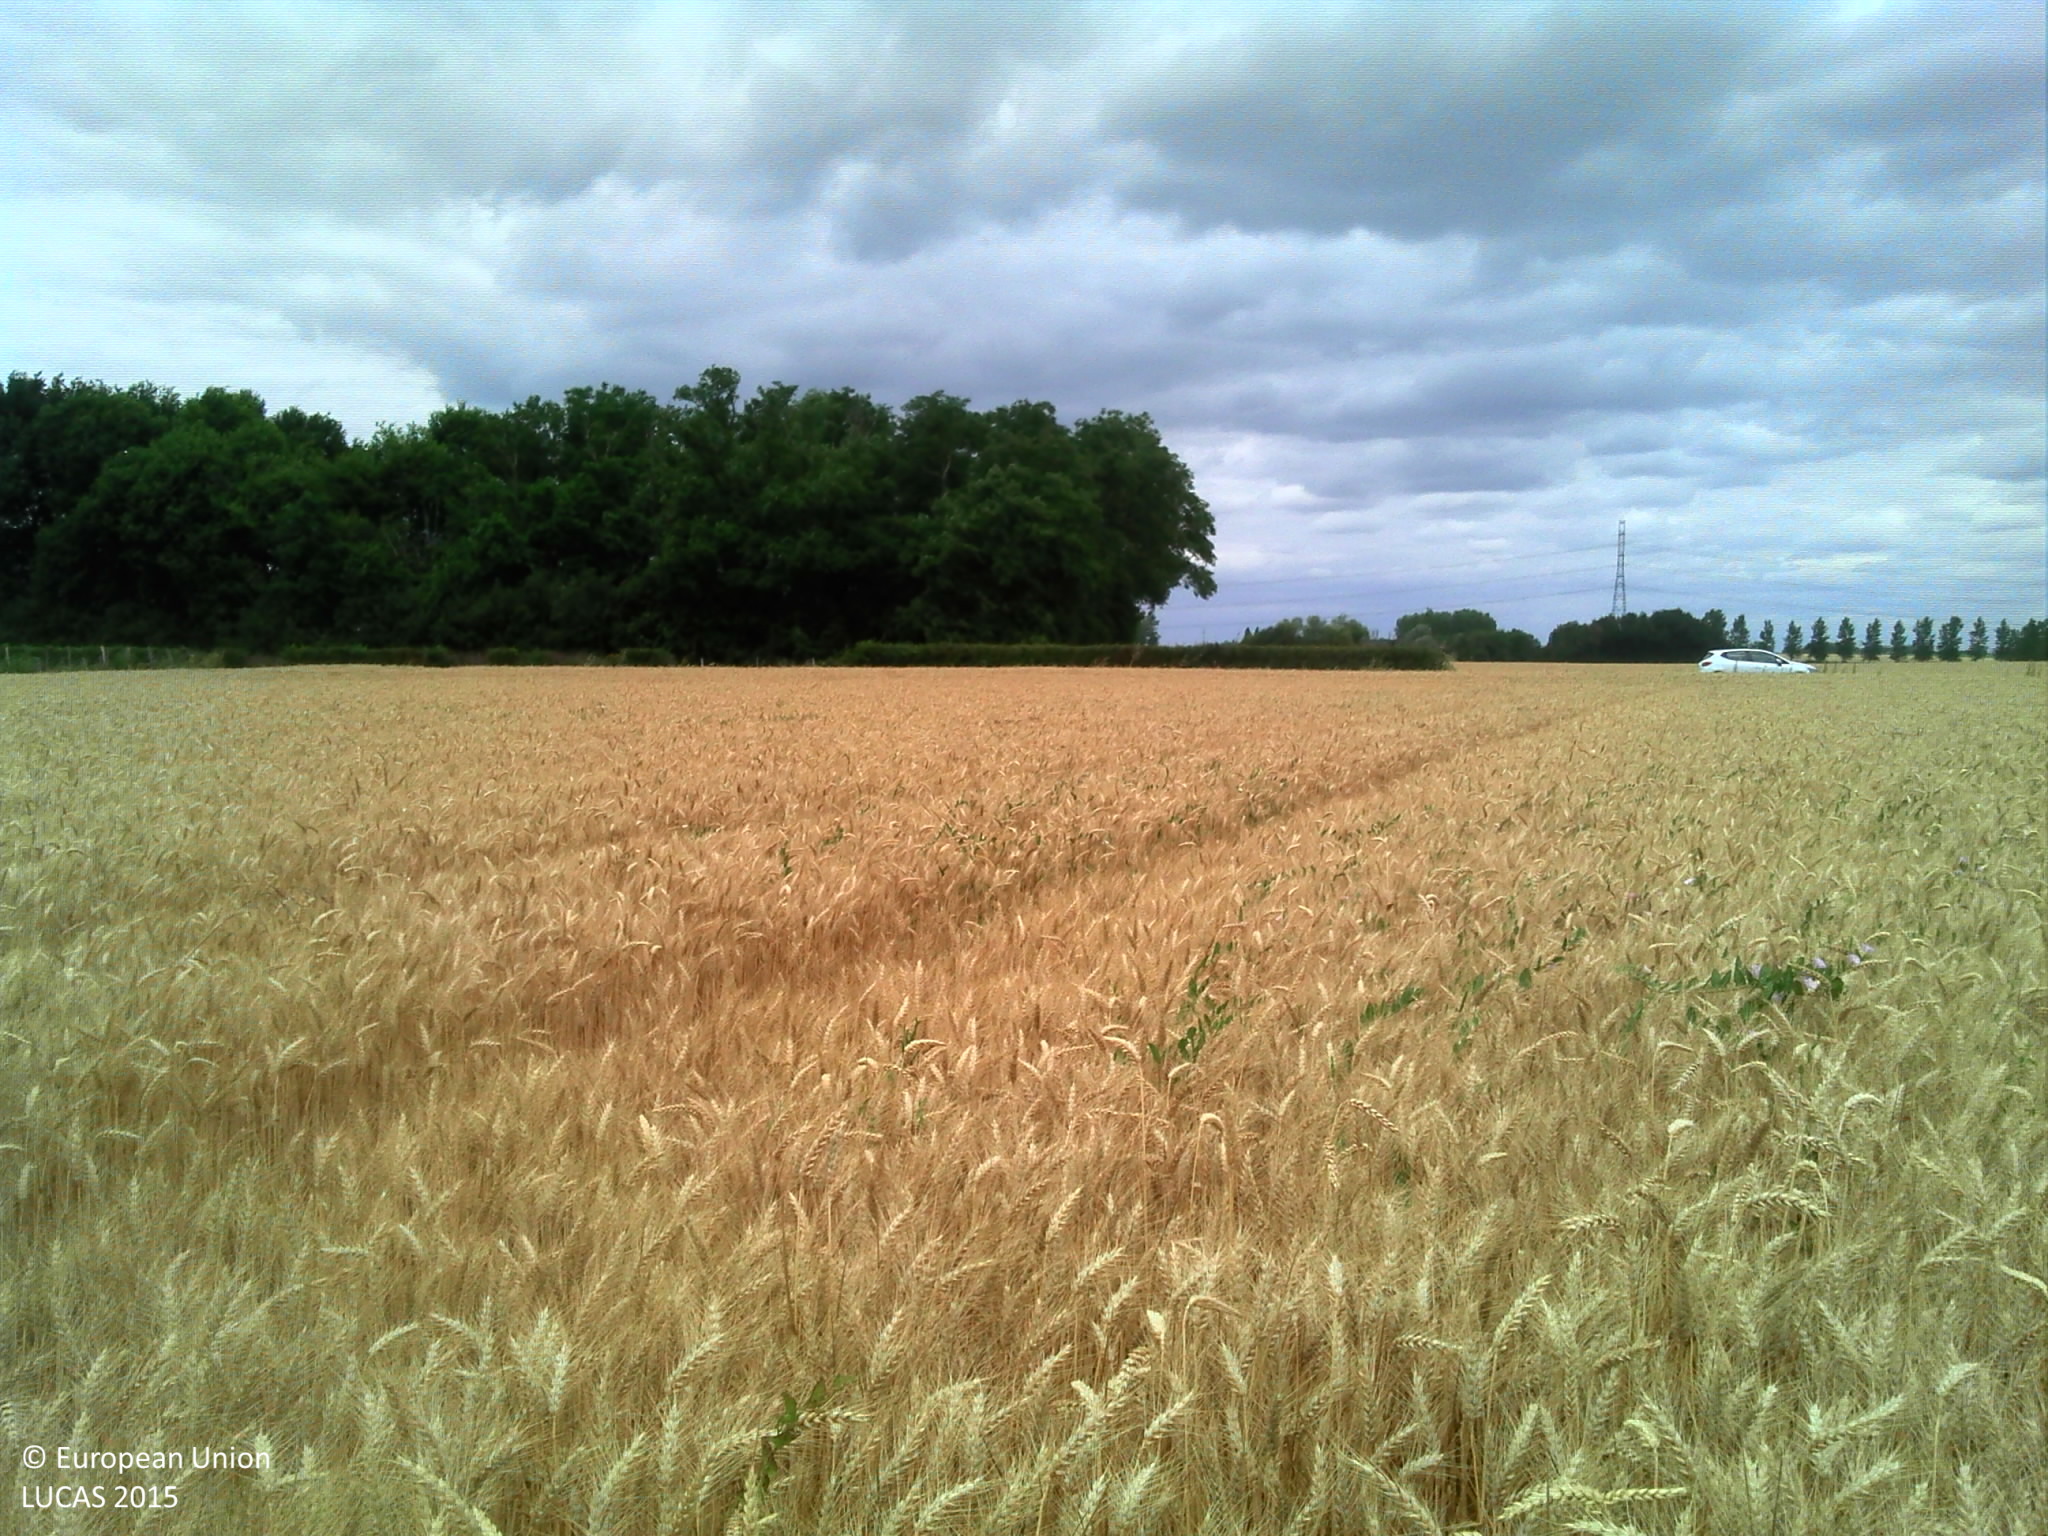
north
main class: Cropland
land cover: Common wheat
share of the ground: > 75 %
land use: Agriculture (excluding fallow land and kitchen gardens)
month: July
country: FR
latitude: 47.3070
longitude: 0.5222
